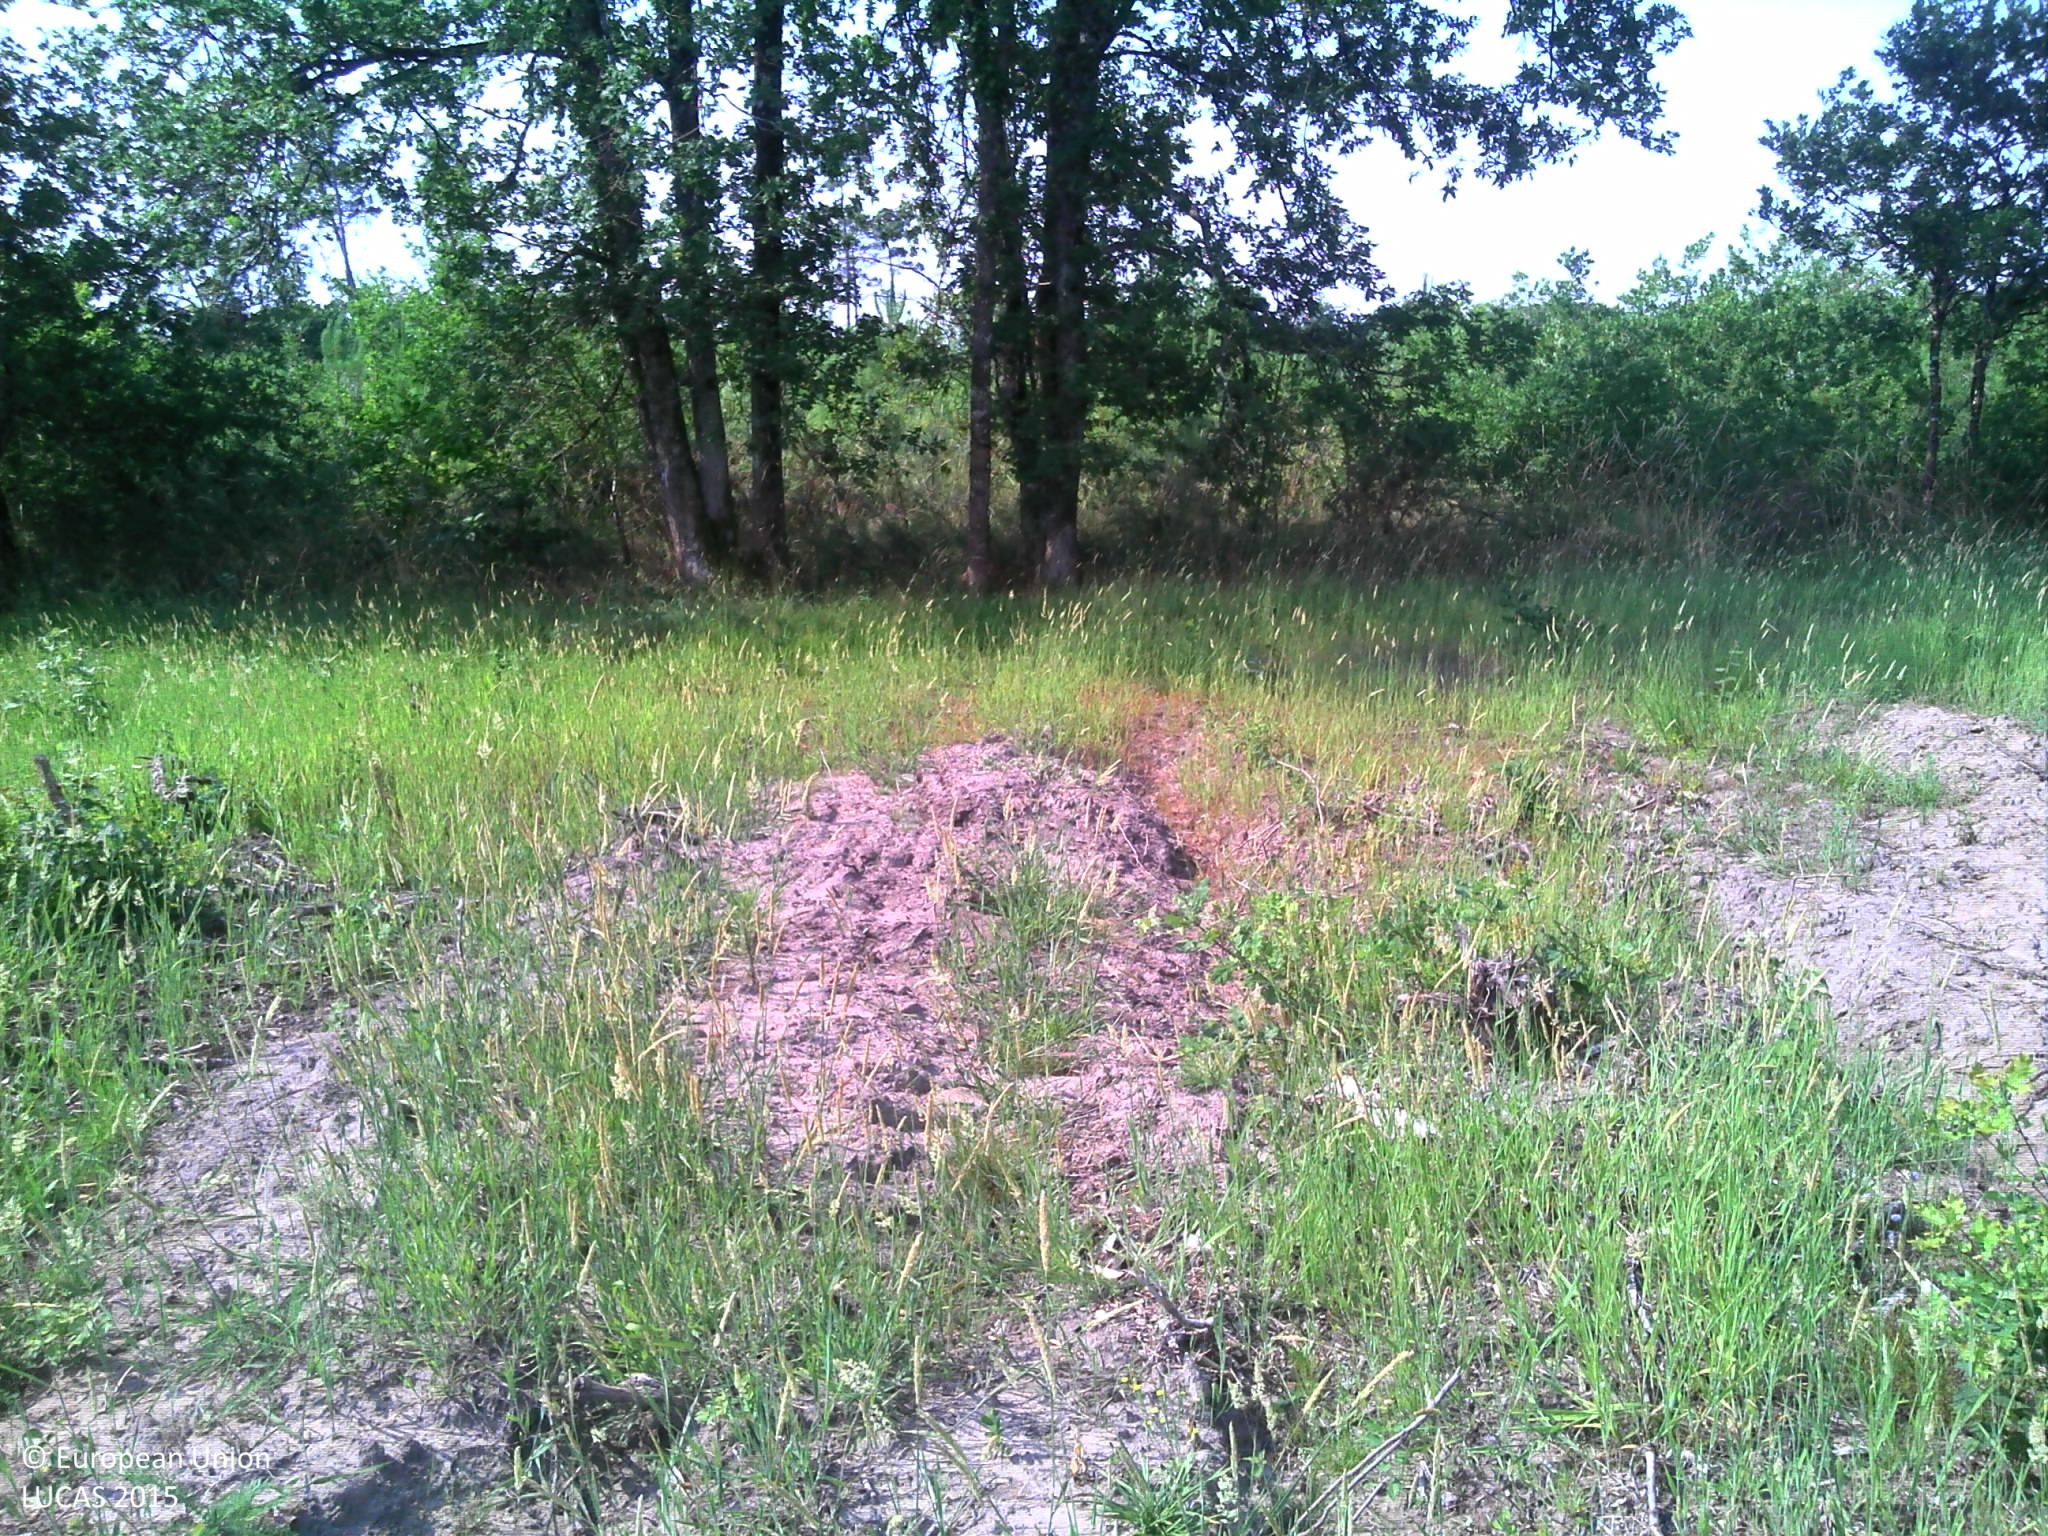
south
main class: Grassland
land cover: Grassland with sparse tree/shrub cover
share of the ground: > 75 %
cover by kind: herbaceous plants 80 %, shrubs 10 %, coniferous forest trees 5 %, unconsolidated bare surface 5 %
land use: Forestry
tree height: < 5 m
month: June
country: FR
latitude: 43.9446
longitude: -0.4904
